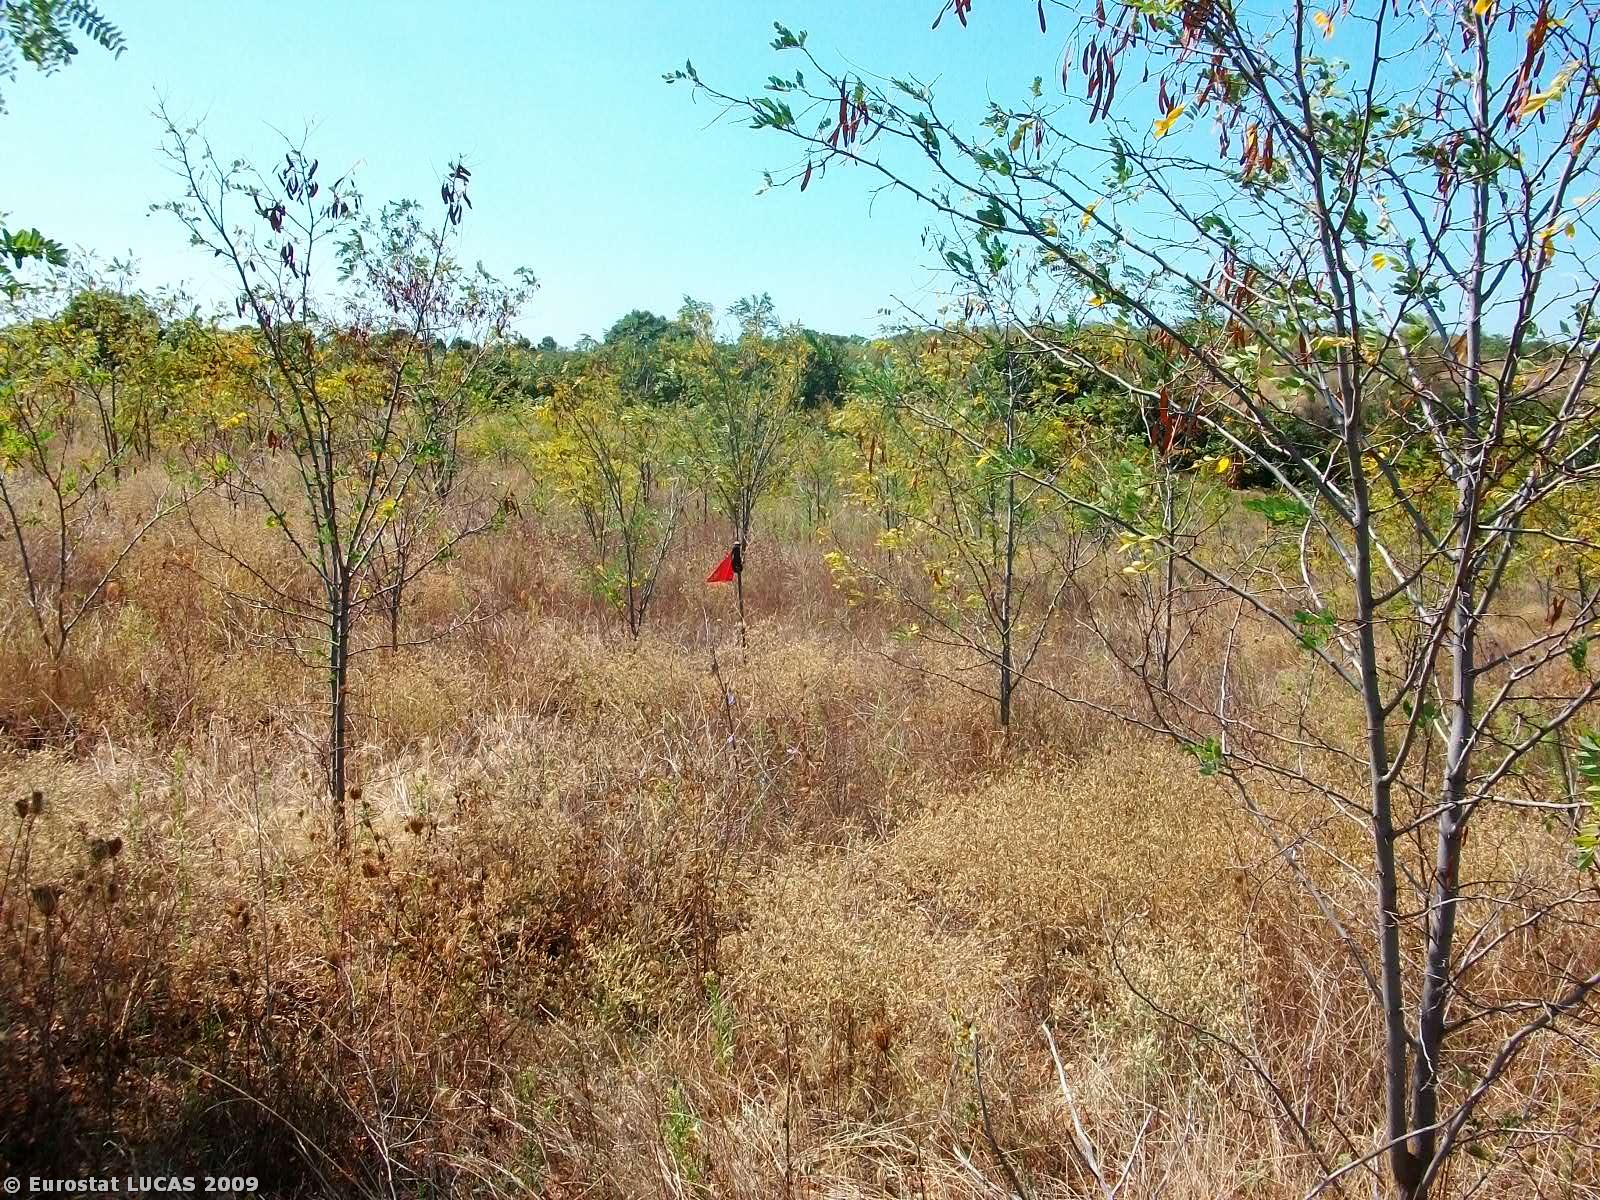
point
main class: Woodland
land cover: Broadleaved woodland
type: plantations and self-sown exotic forest
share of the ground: 25 - 50 %
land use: Forestry
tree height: > 5 m
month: September
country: GR
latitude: 41.3396
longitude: 26.3123
